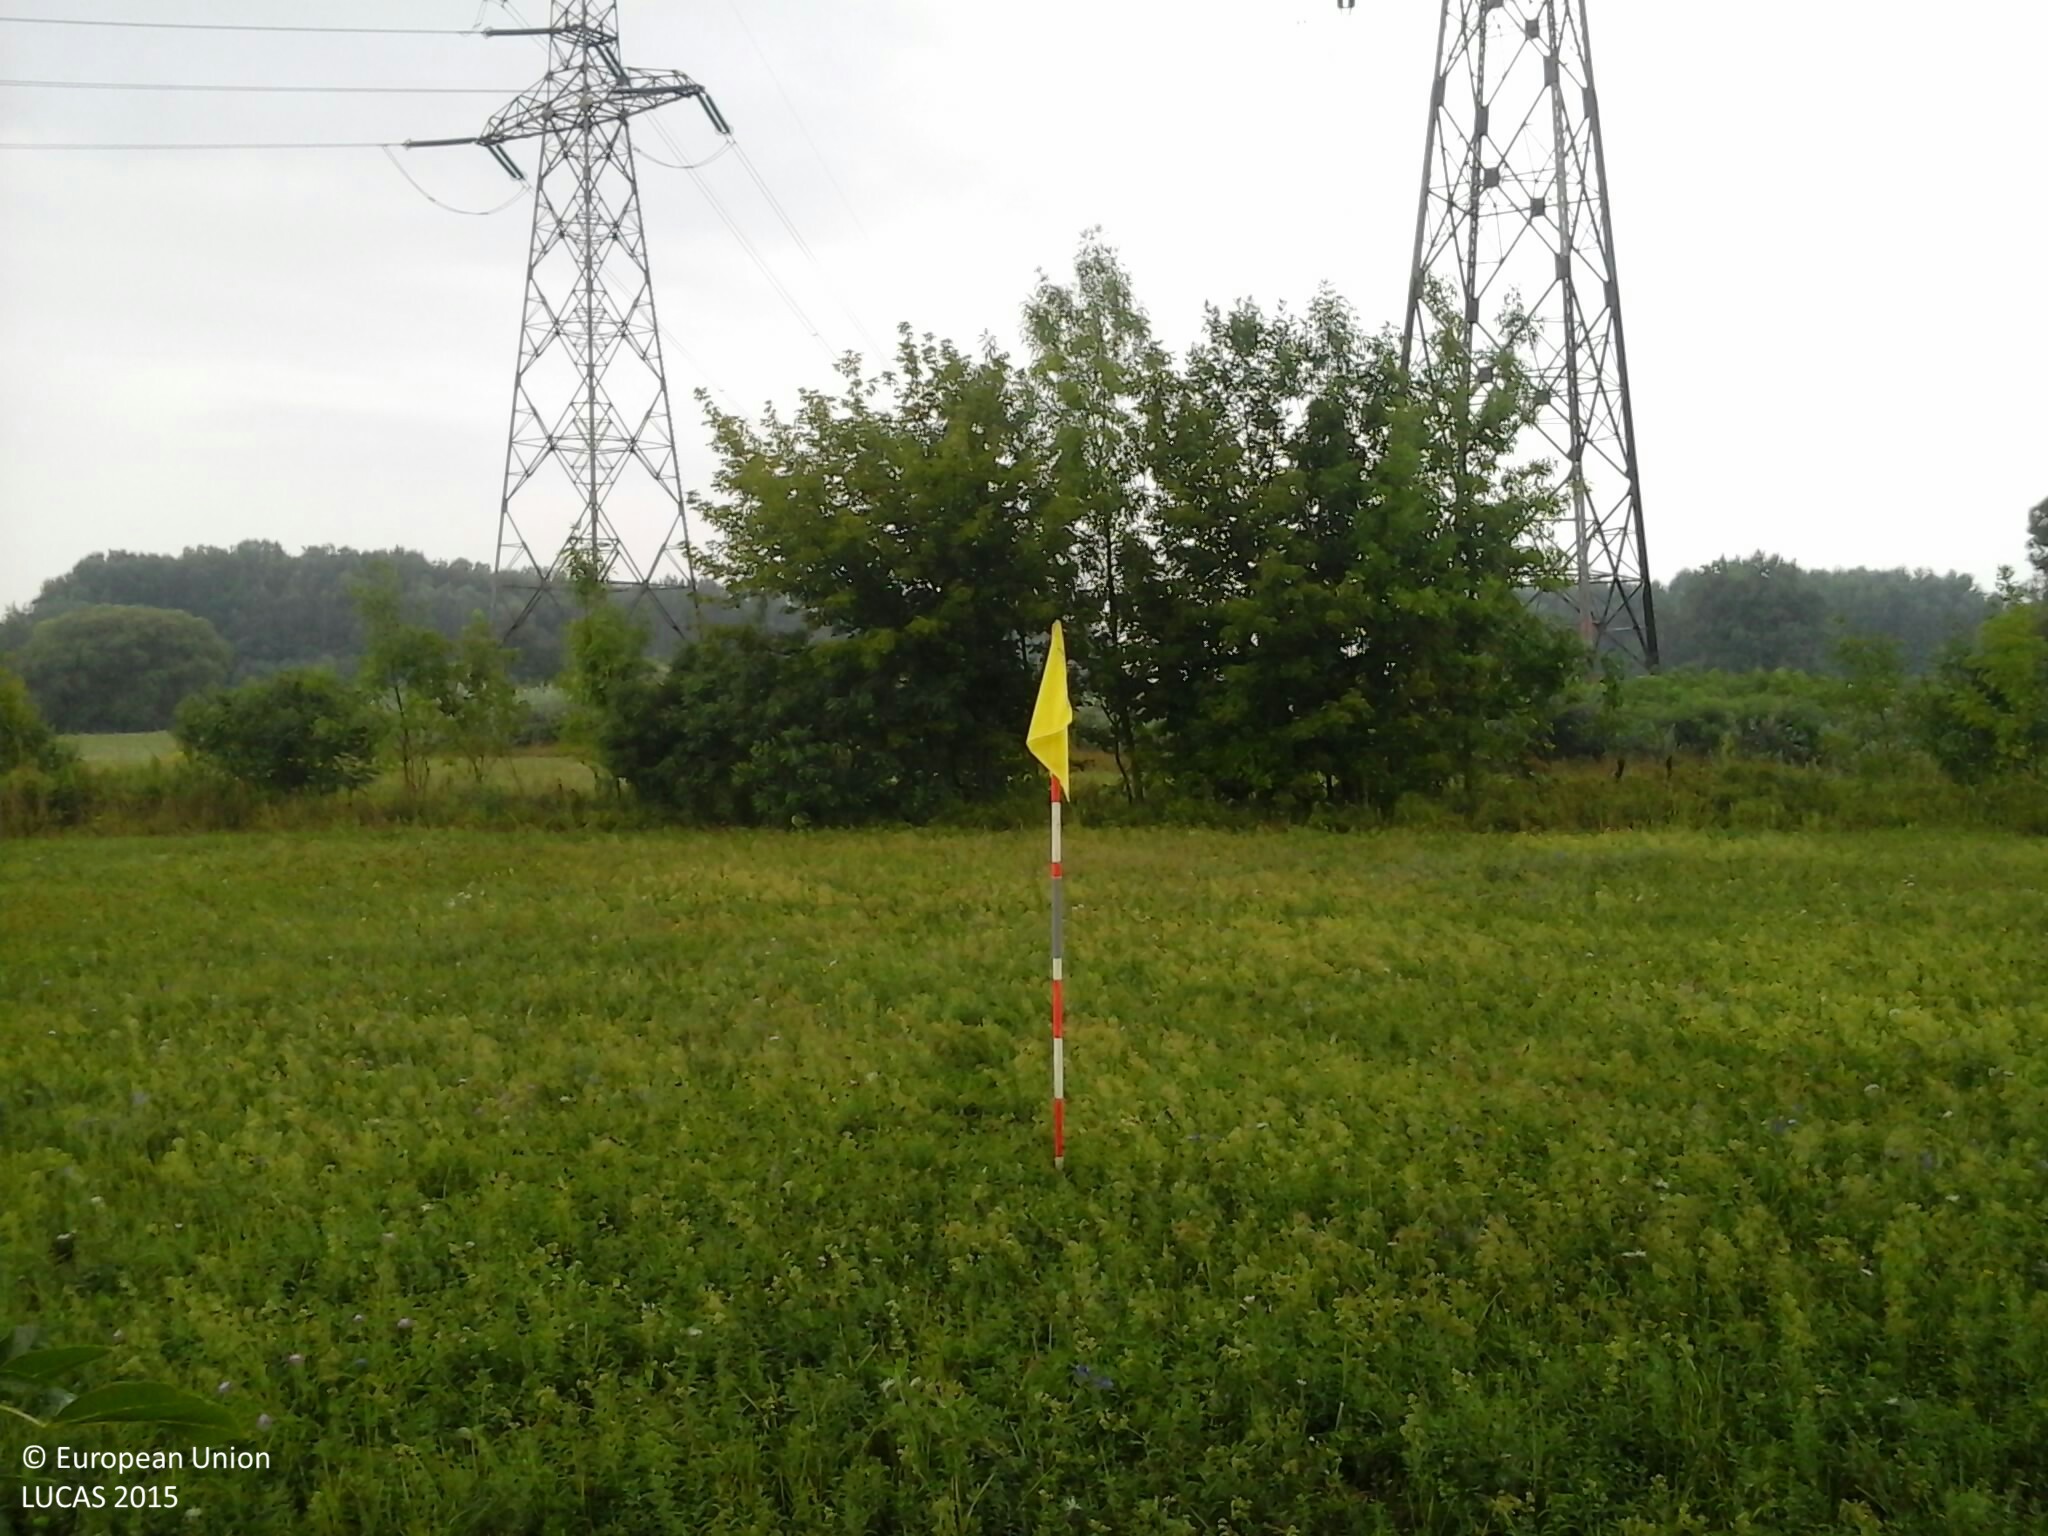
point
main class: Grassland
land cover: Grassland with sparse tree/shrub cover
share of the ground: > 75 %
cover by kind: herbaceous plants 85 %, shrubs 10 %, broadleaved forest trees 5 %
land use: Agriculture (excluding fallow land and kitchen gardens)
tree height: > 5 m
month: August
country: HU
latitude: 47.9353
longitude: 21.0829
